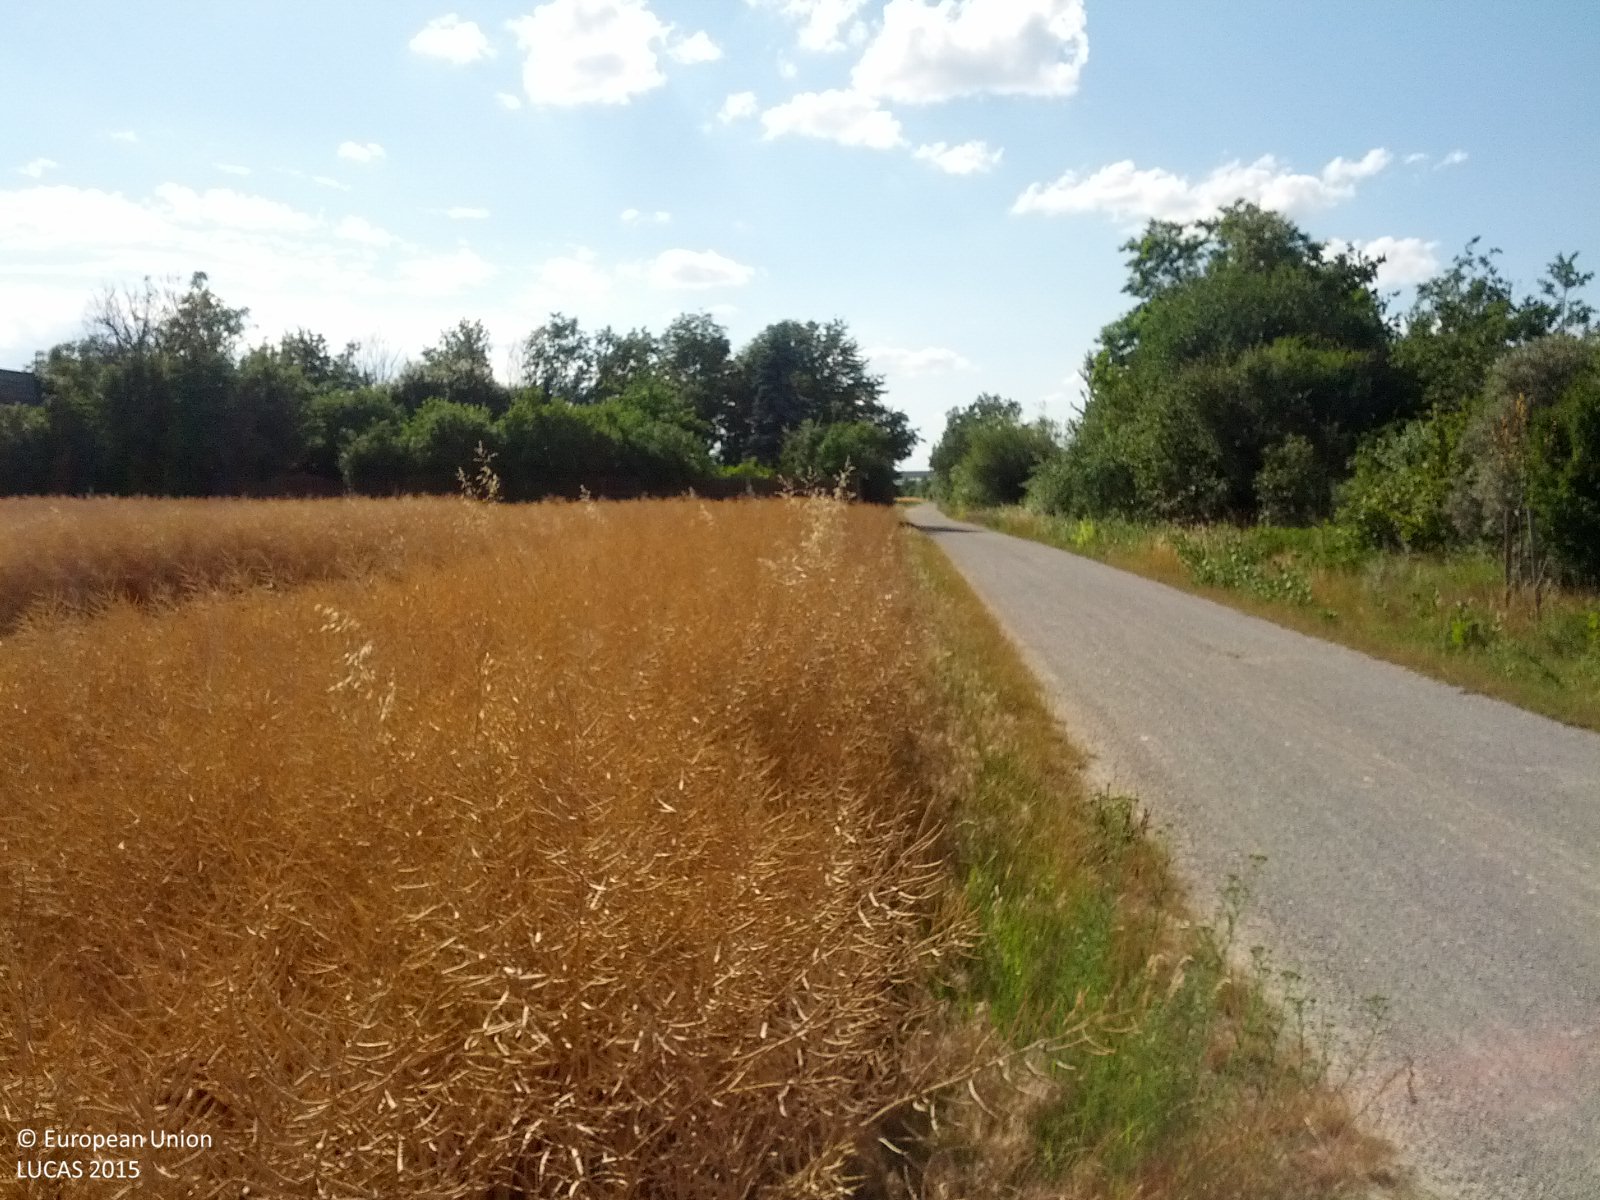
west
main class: Cropland
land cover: Rape and turnip rape
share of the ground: > 75 %
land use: Agriculture (excluding fallow land and kitchen gardens)
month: June
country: AT
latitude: 48.3015
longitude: 16.5171
